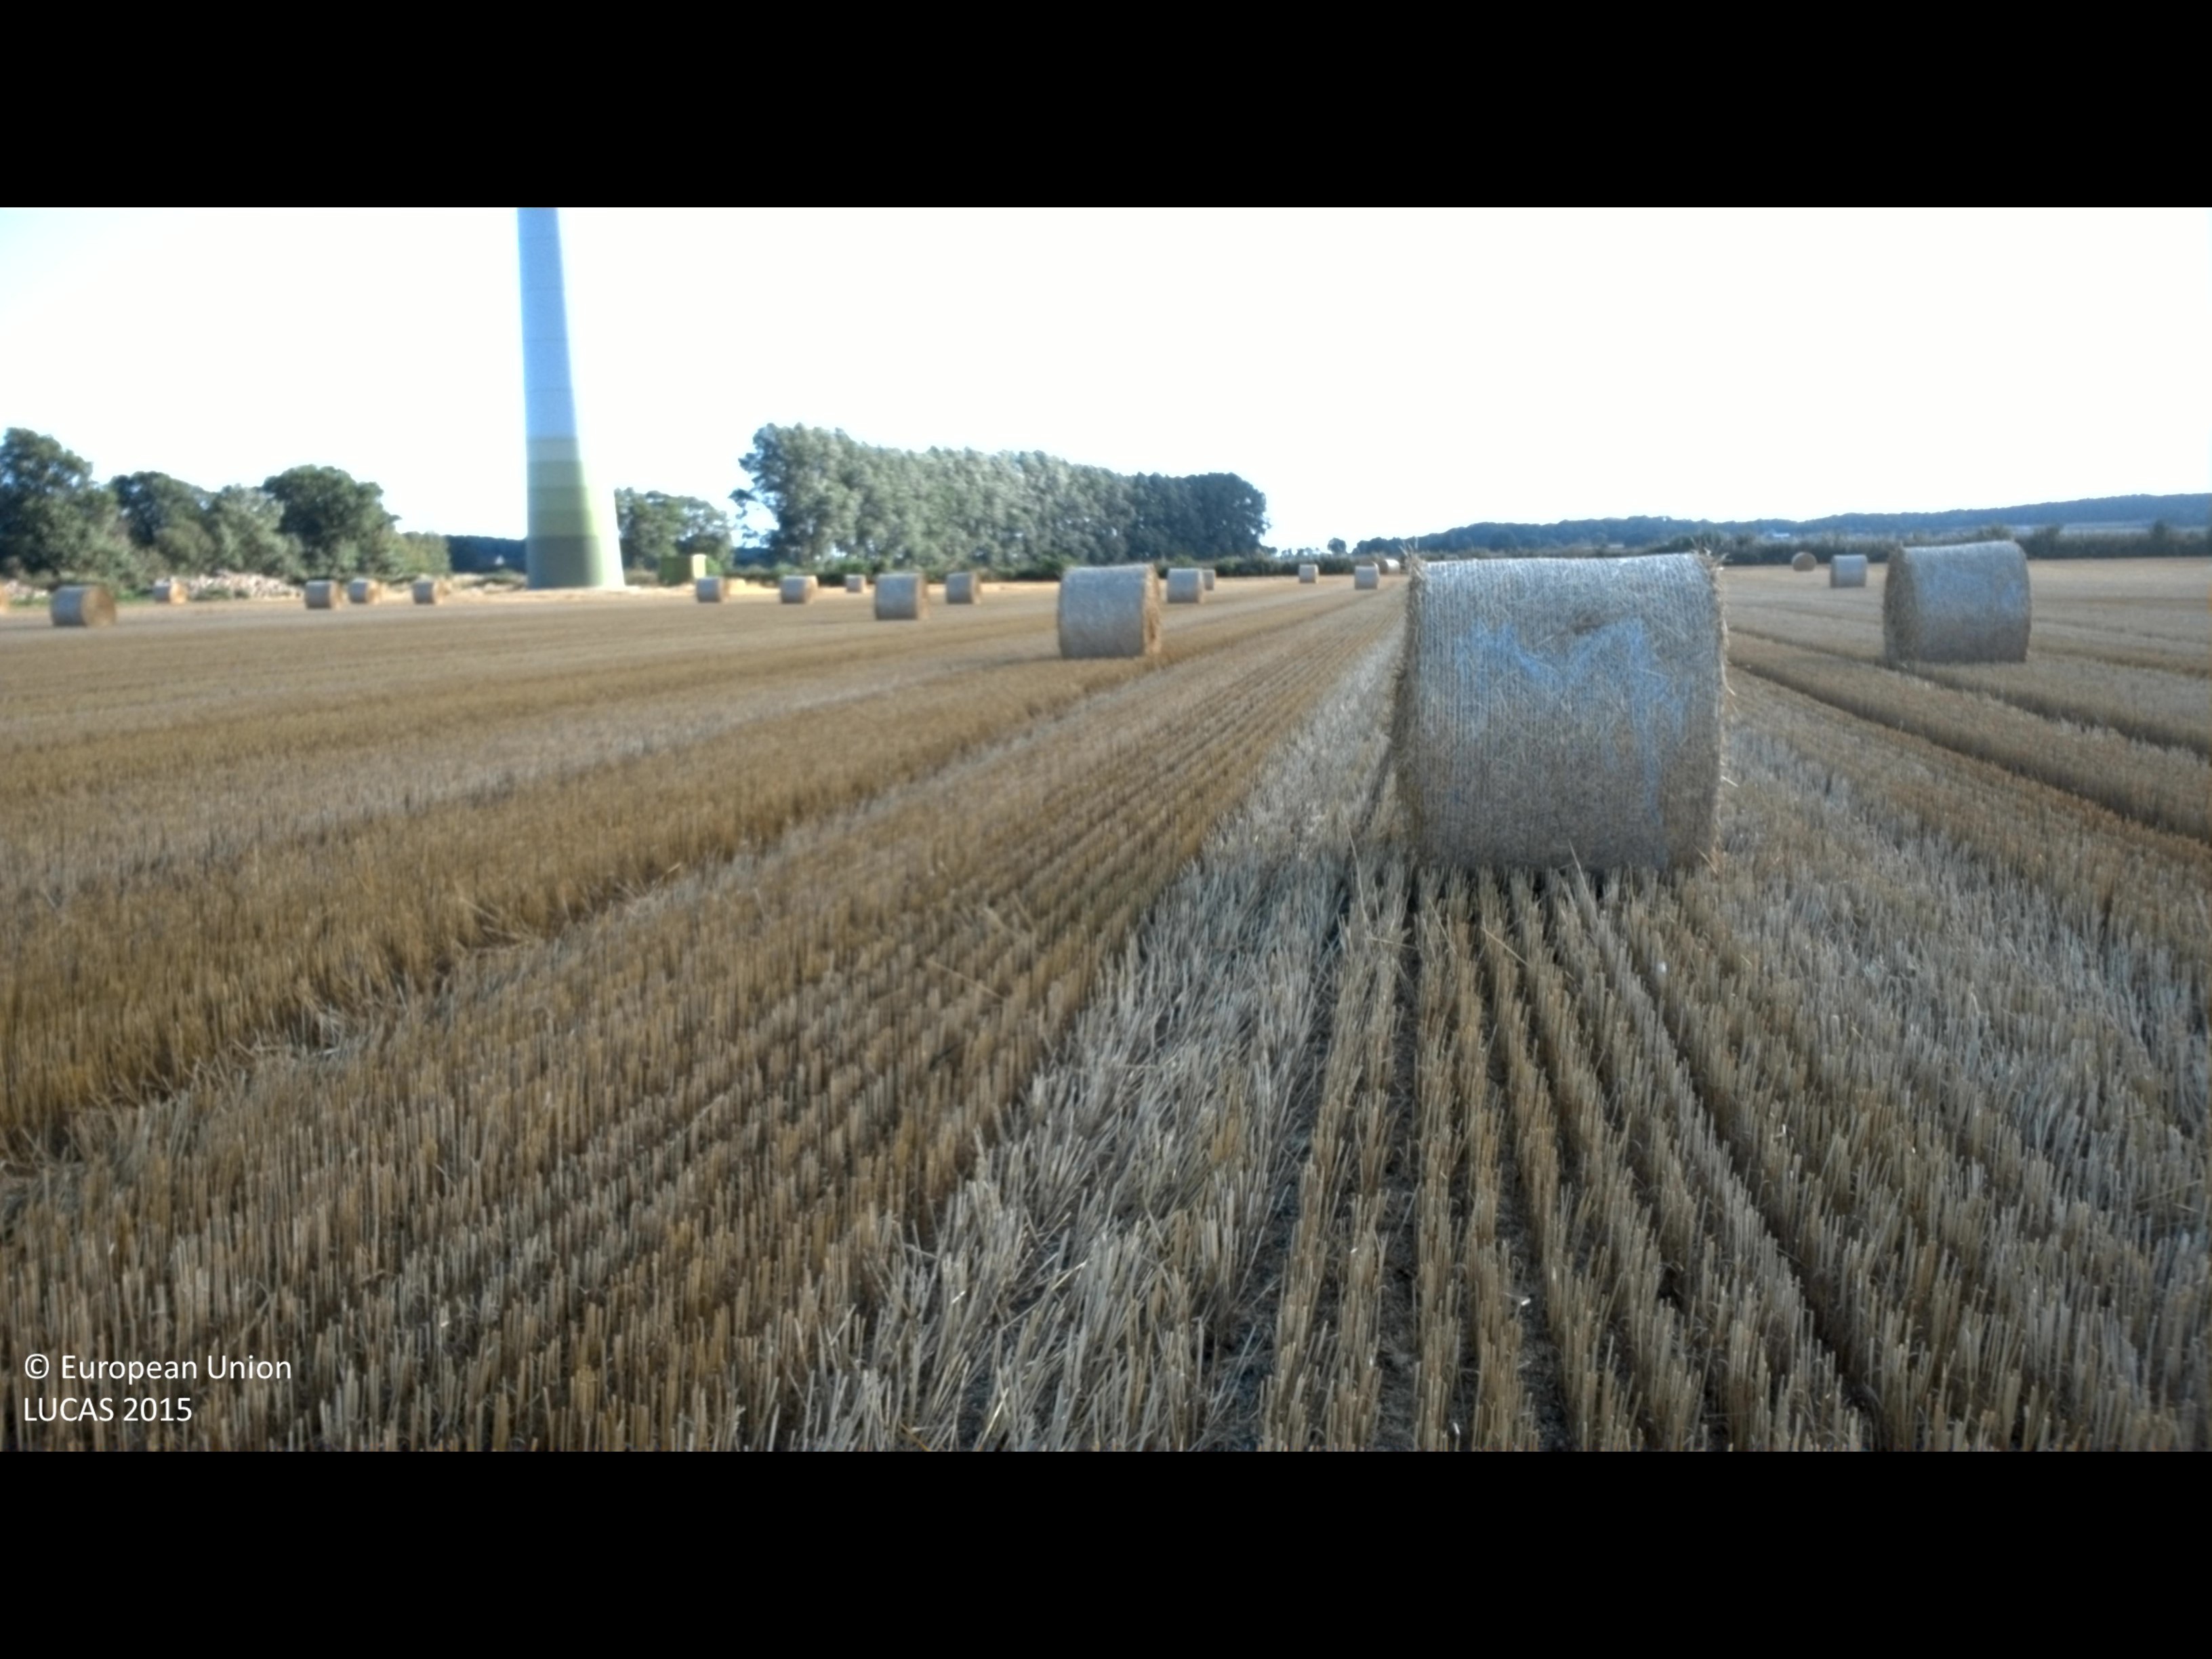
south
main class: Cropland
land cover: Common wheat
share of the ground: > 75 %
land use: Agriculture (excluding fallow land and kitchen gardens)
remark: Harvested field
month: September
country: SE
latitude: 56.0309
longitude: 14.6683
